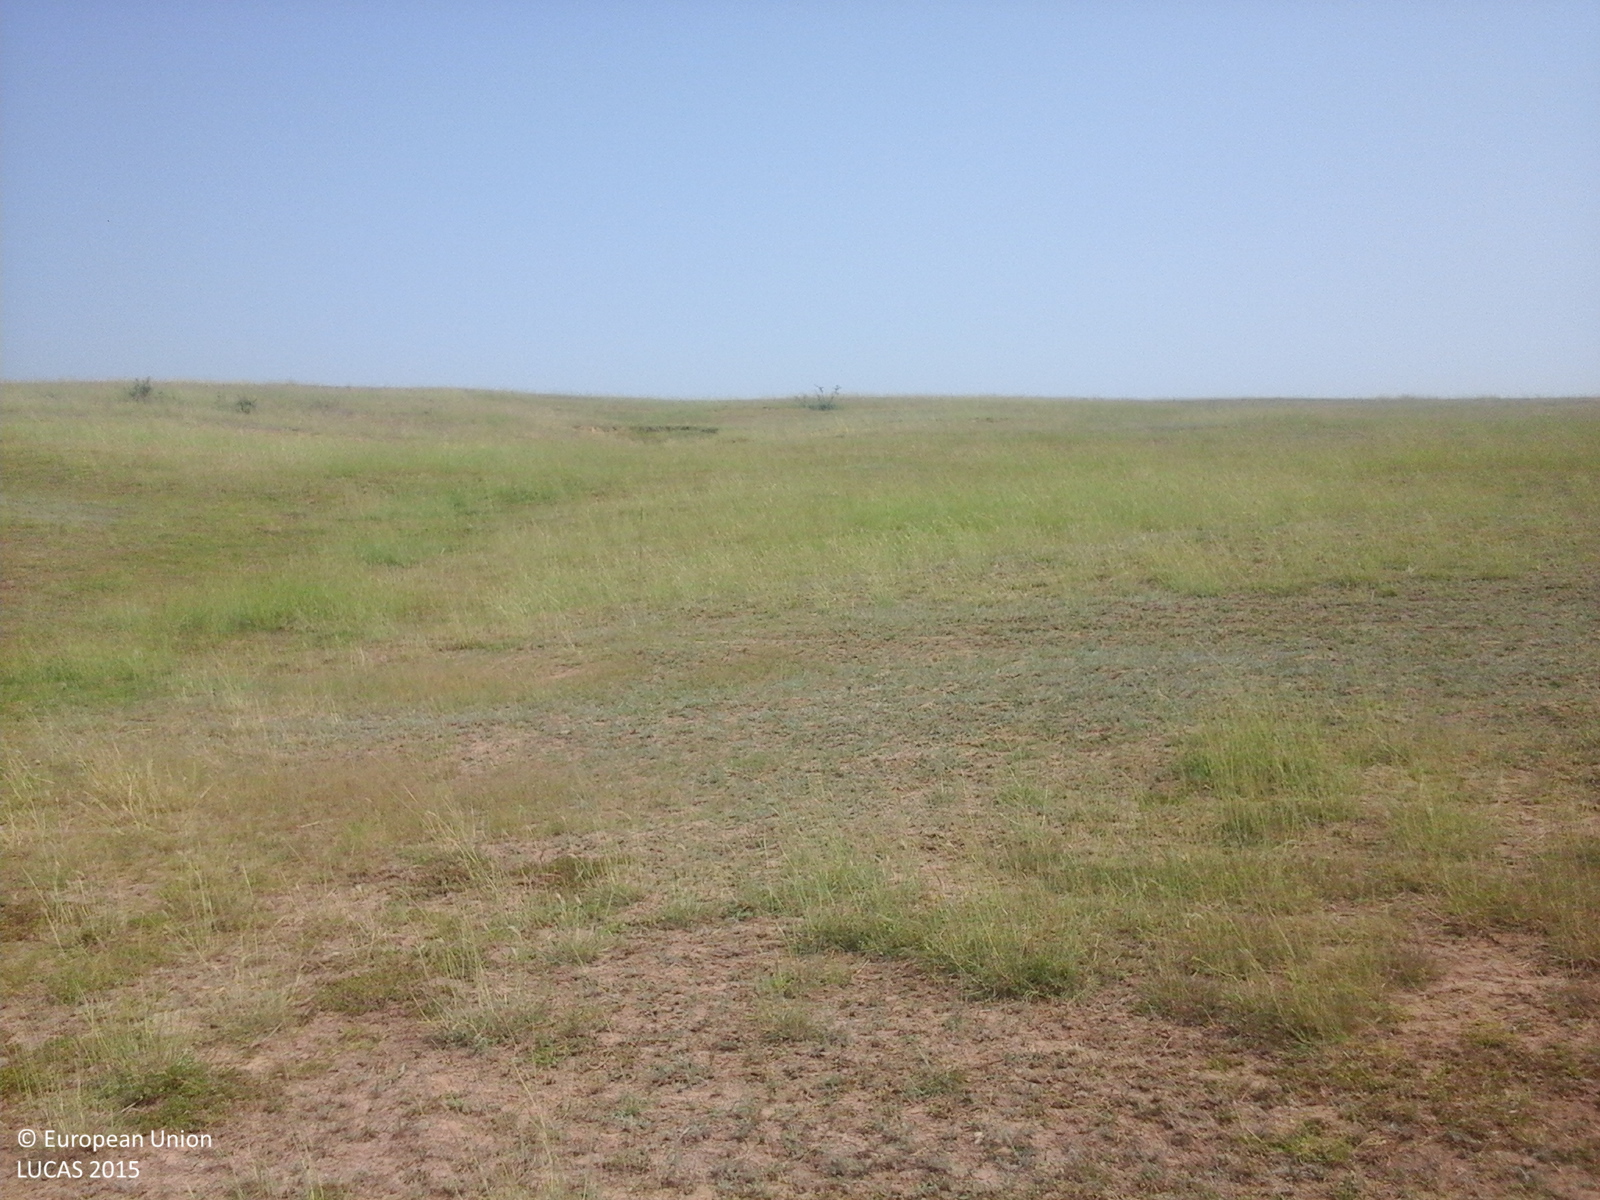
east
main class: Grassland
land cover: Grassland without tree/shrub cover
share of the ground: 50 - 75 %
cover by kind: herbaceous plants 100 %
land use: Agriculture (excluding fallow land and kitchen gardens)
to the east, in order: Grassland without tree/shrub cover; Tracks; Maize
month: July
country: RO
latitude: 45.8830
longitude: 27.9662
